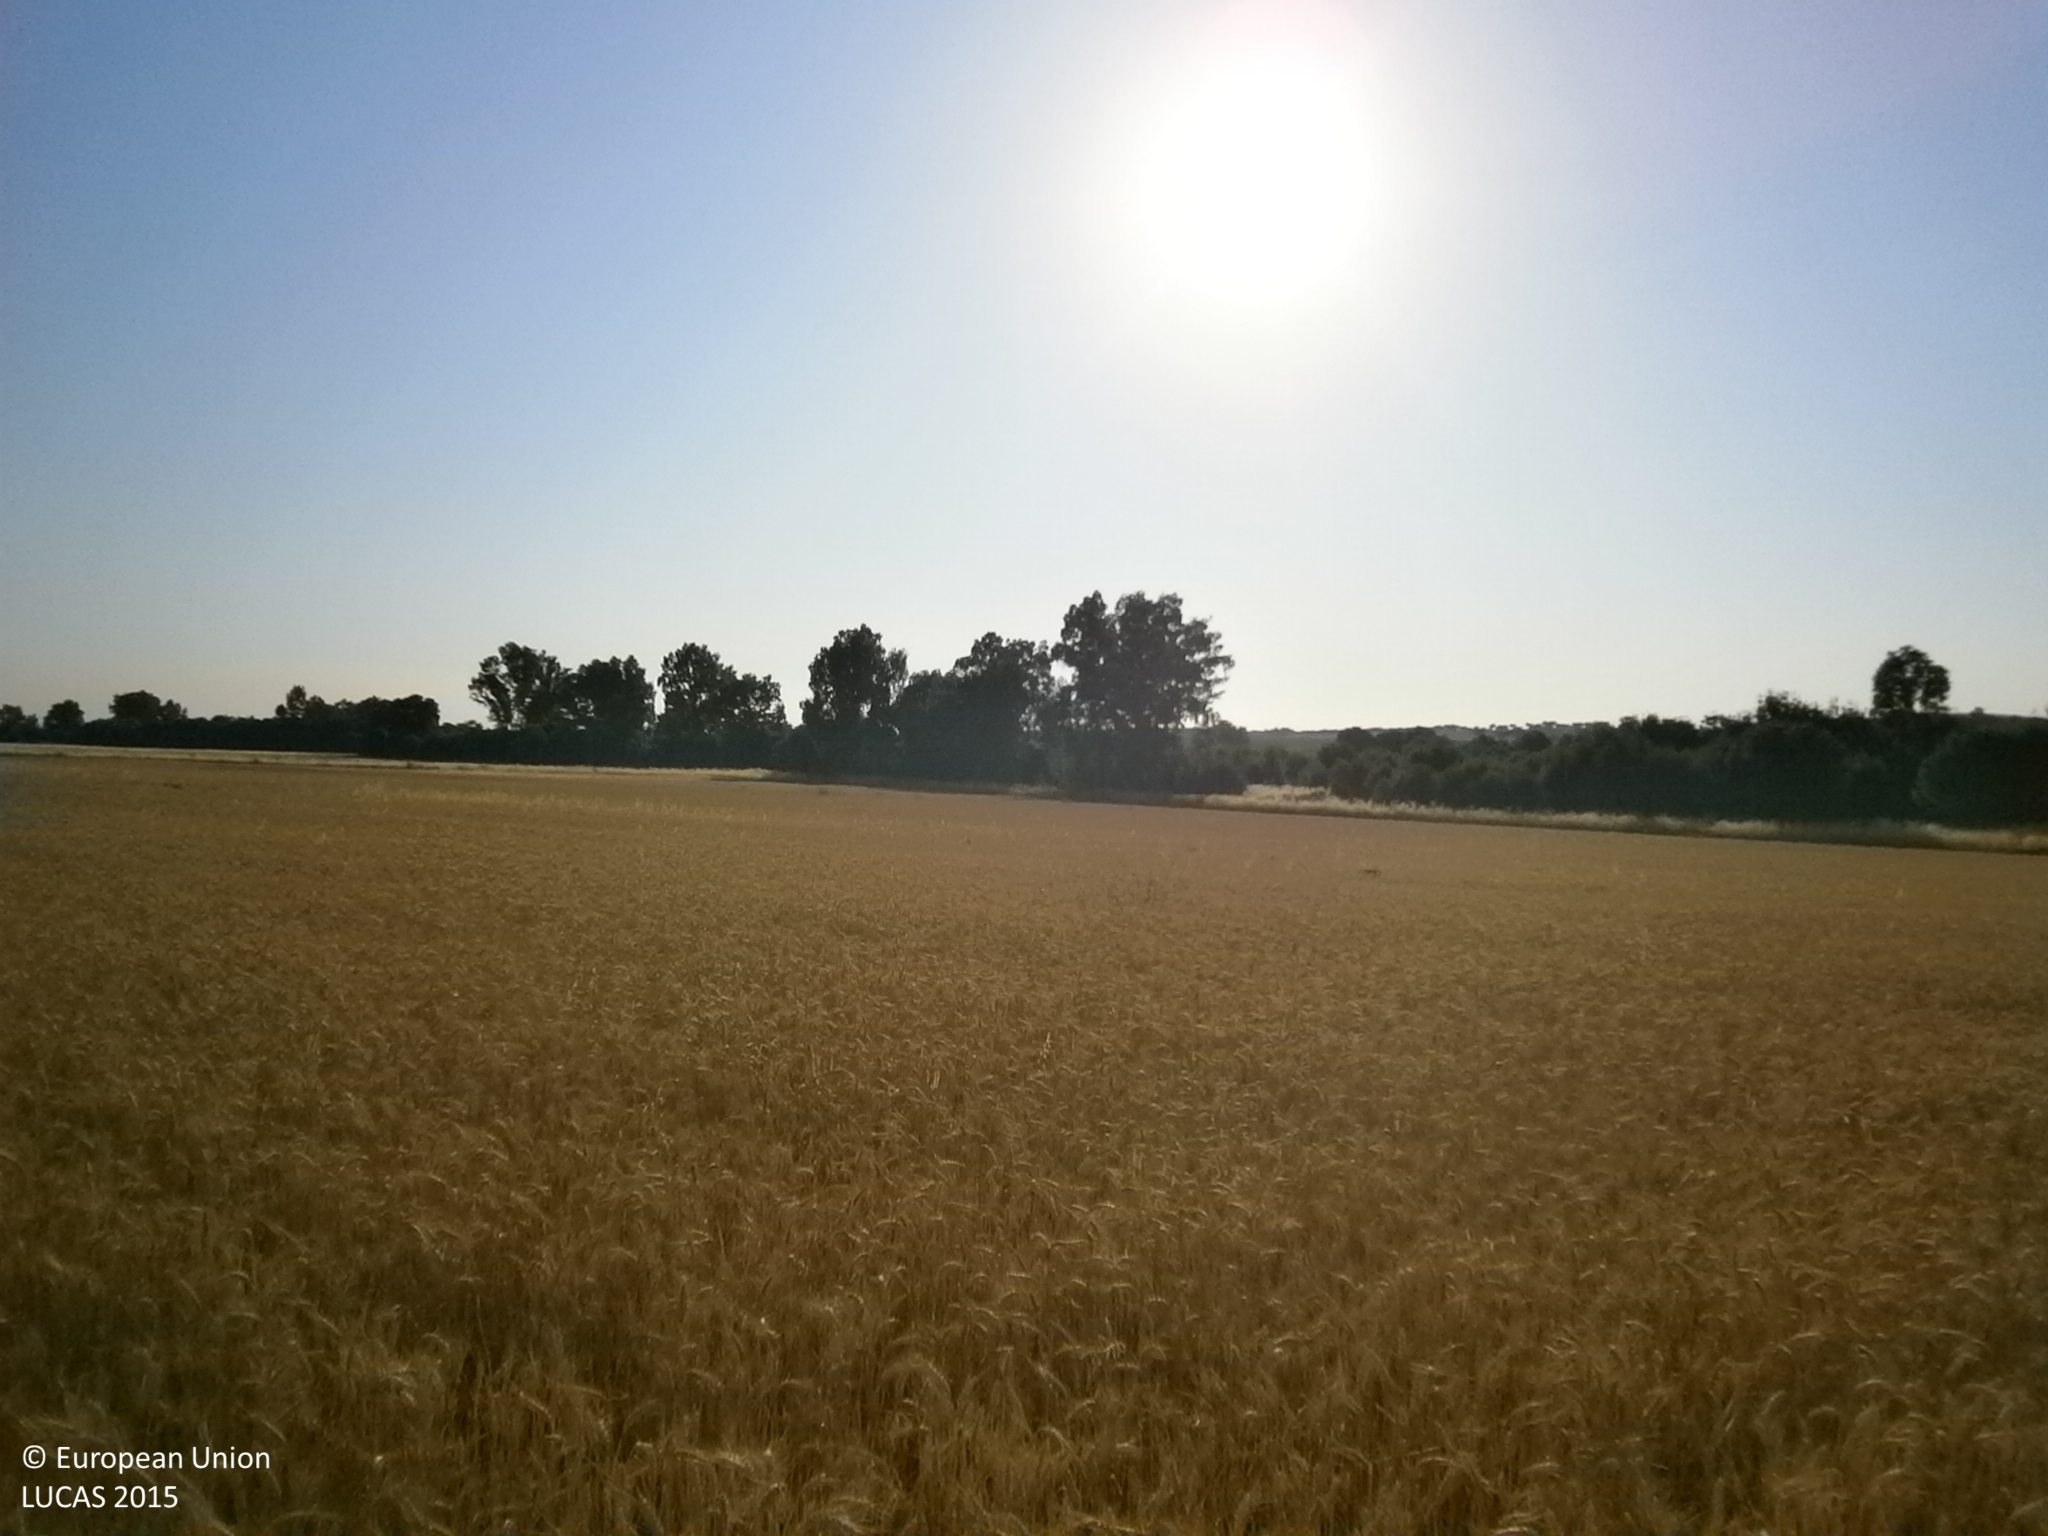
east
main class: Cropland
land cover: Barley
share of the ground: > 75 %
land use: Agriculture (excluding fallow land and kitchen gardens)
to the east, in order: Barley; Tracks; Shrubland with sparse tree cover; Rivers and streams; Shrubland with sparse tree cover; Tracks; Barley; Tracks
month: June
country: ES
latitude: 38.7506
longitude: -6.8058
